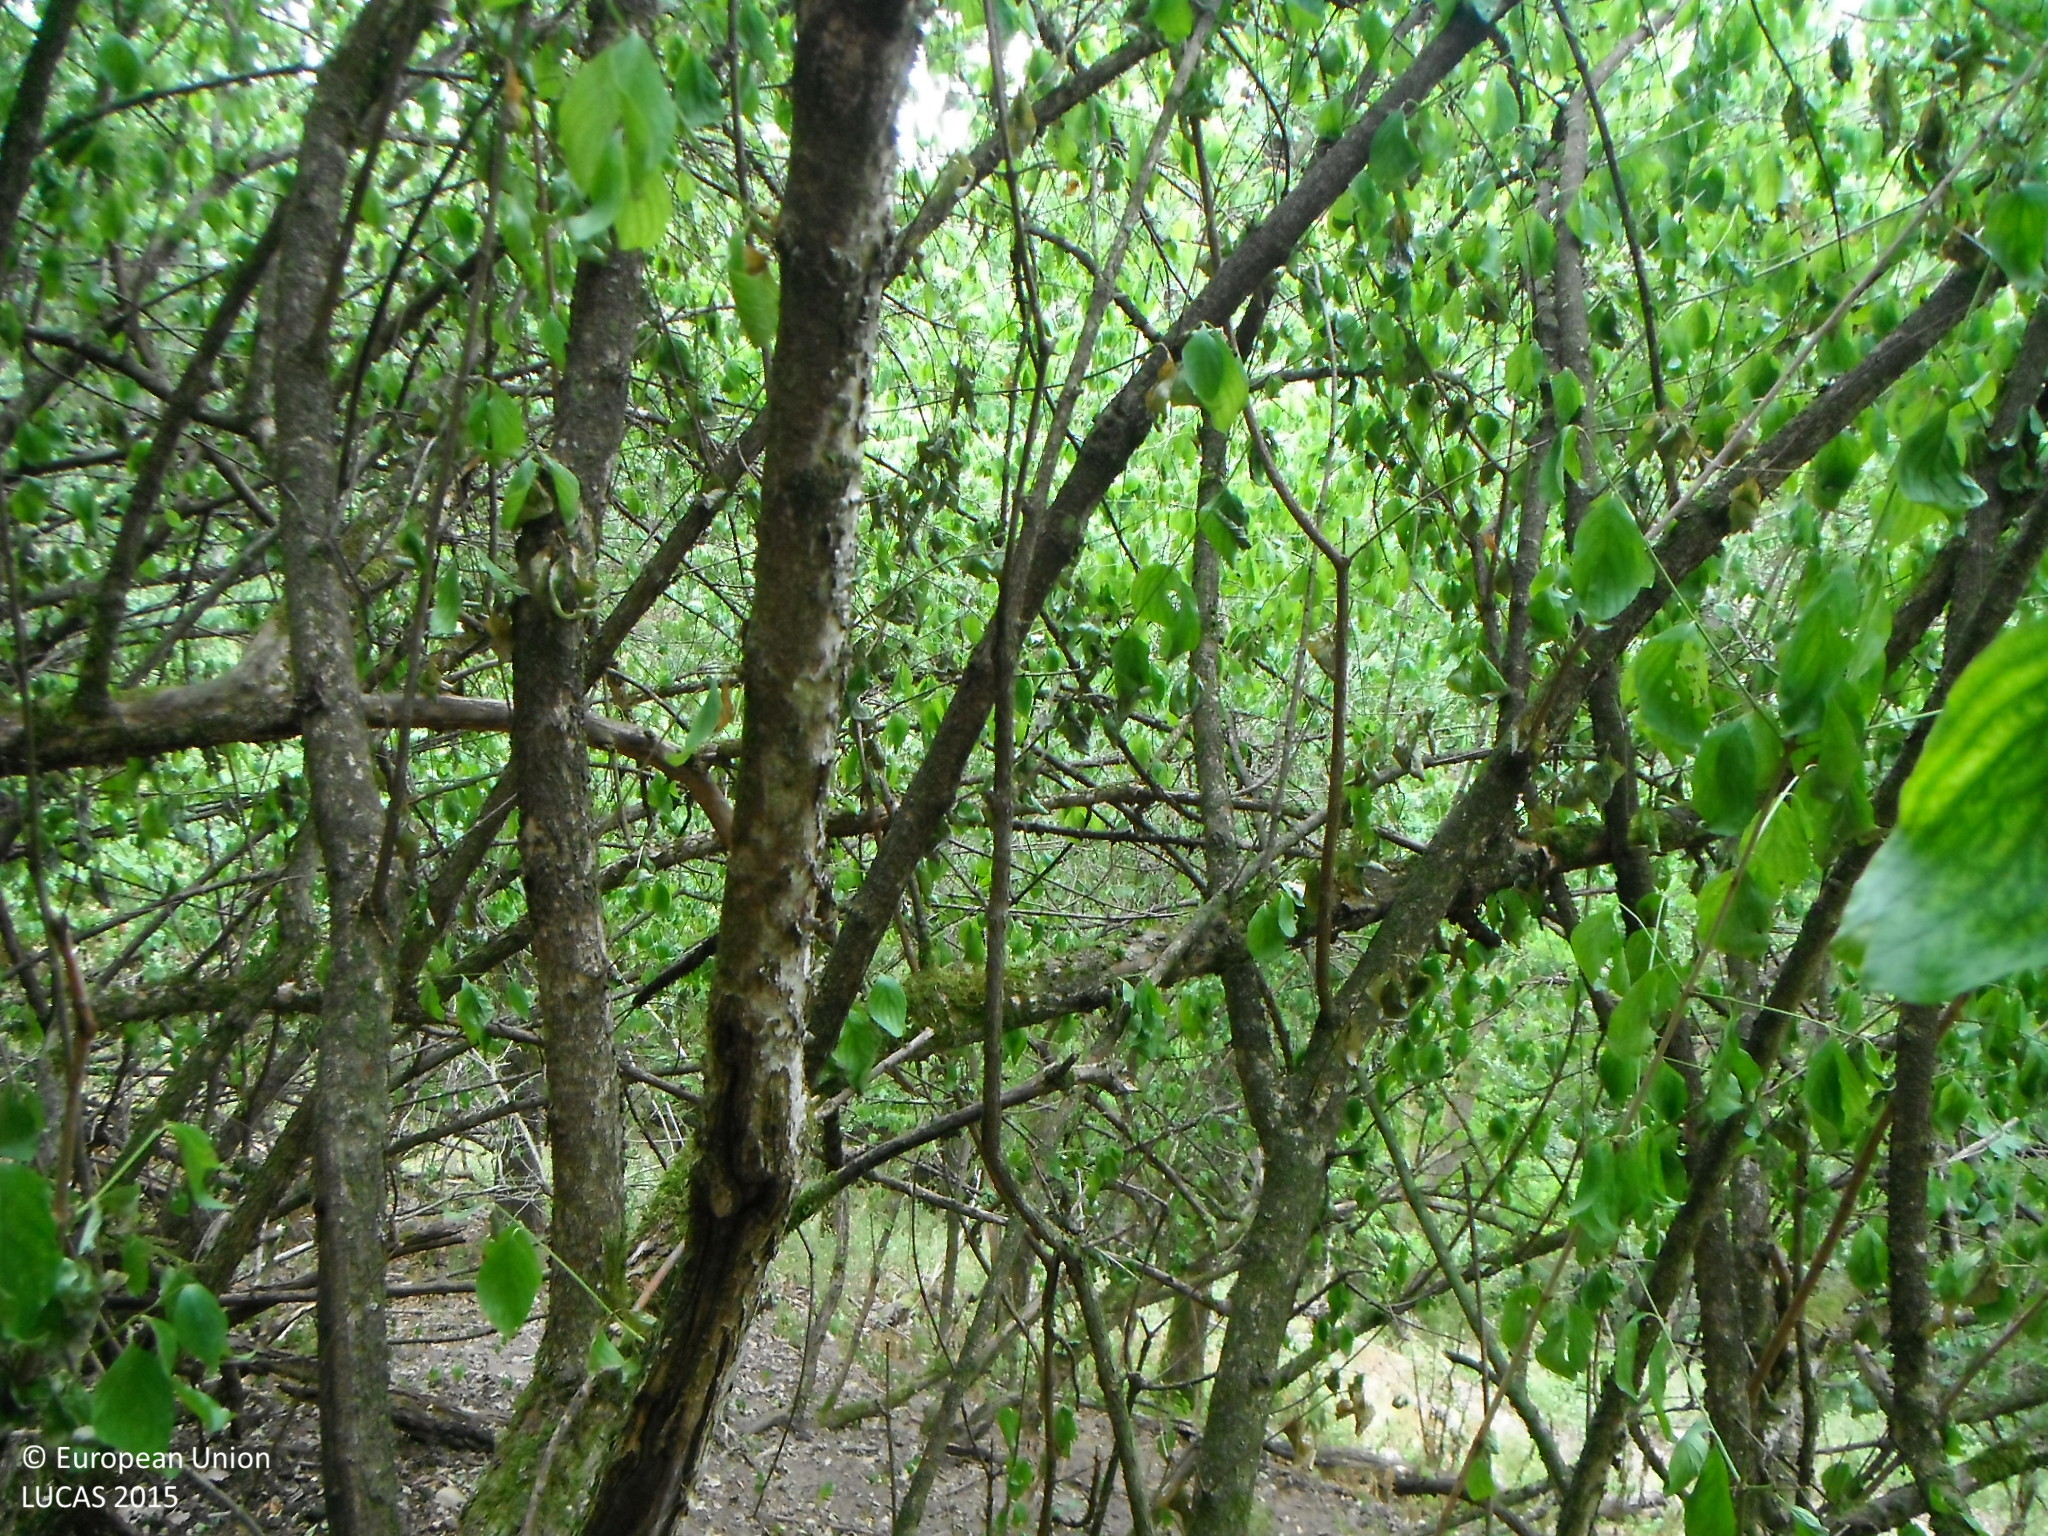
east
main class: Woodland
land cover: Broadleaved woodland
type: mesophytic deciduous forest
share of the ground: > 75 %
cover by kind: broadleaved forest trees 100 %
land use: Forestry
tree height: > 5 m
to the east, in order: Broadleaved woodland; Rivers and streams; Broadleaved woodland; Grassland without tree/shrub cover; Shrubland without tree cover; Broadleaved woodland; Tracks; Broadleaved woodland
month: July
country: SK
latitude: 48.2841
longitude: 19.0633
